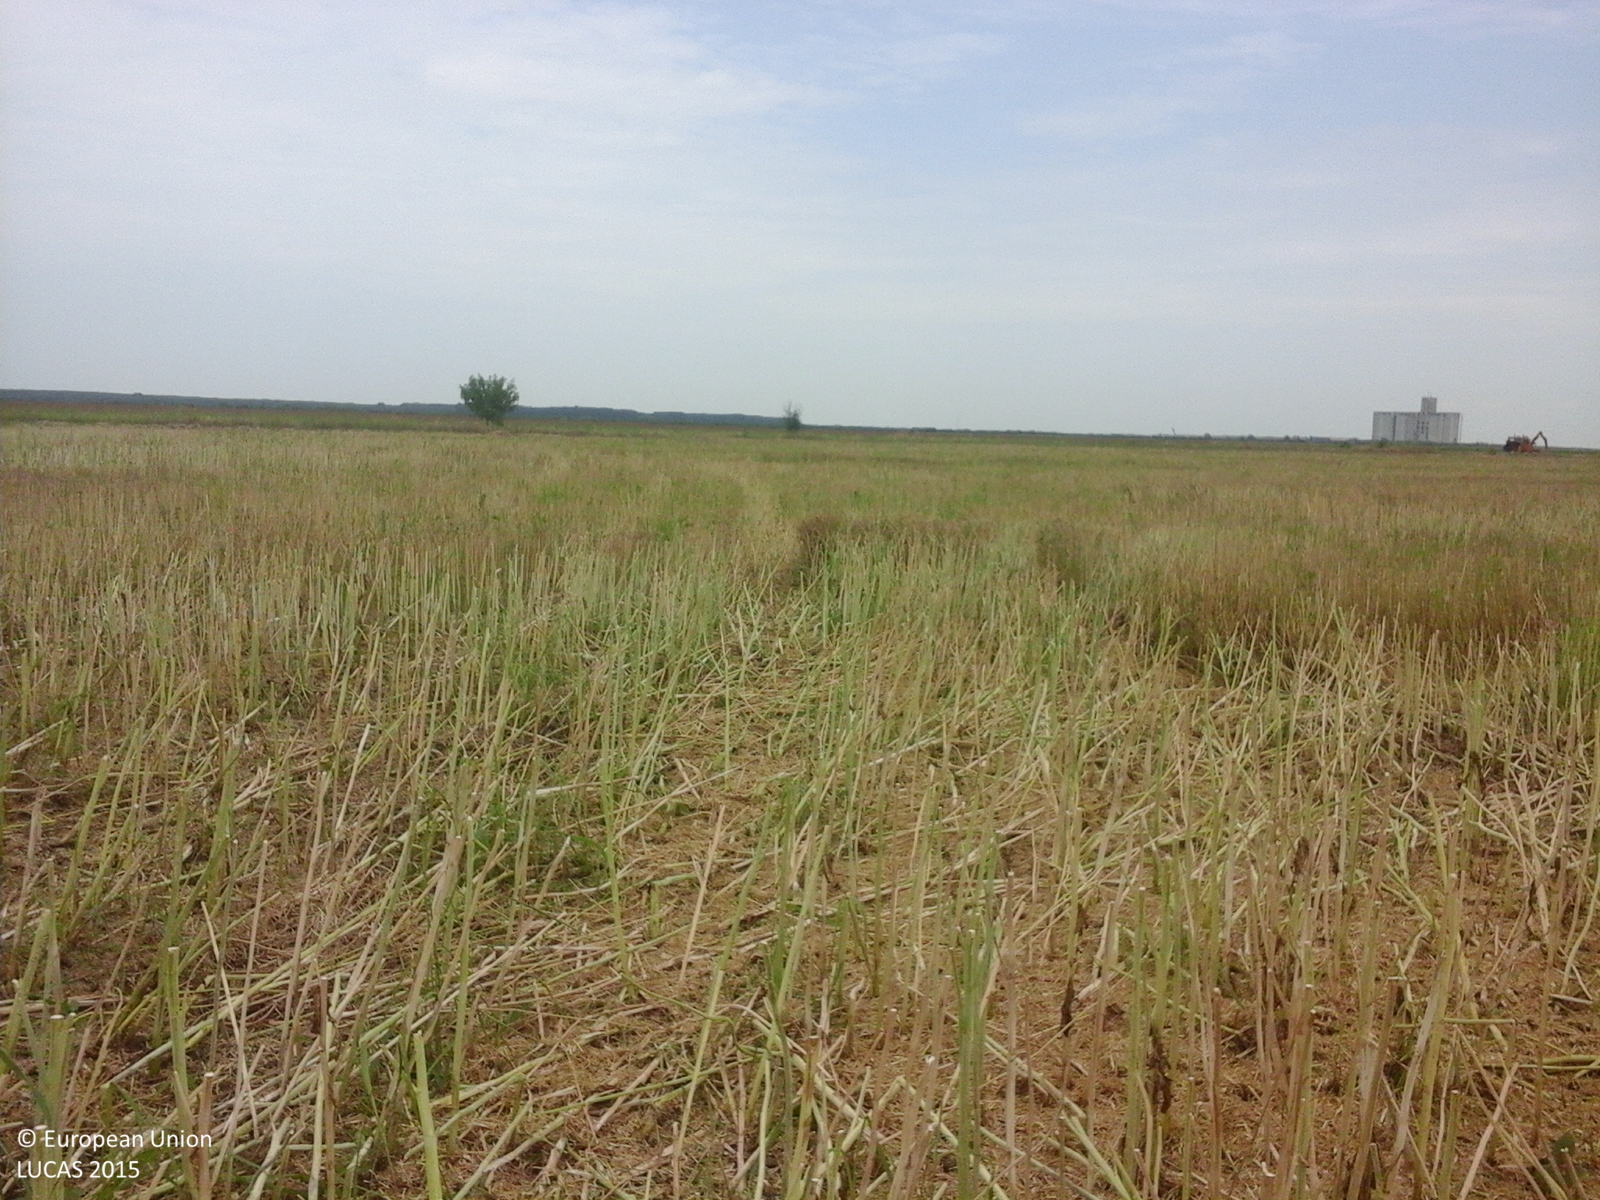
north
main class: Cropland
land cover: Rape and turnip rape
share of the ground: < 10 %
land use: Agriculture (excluding fallow land and kitchen gardens)
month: July
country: RO
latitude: 44.0305
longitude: 26.0327
